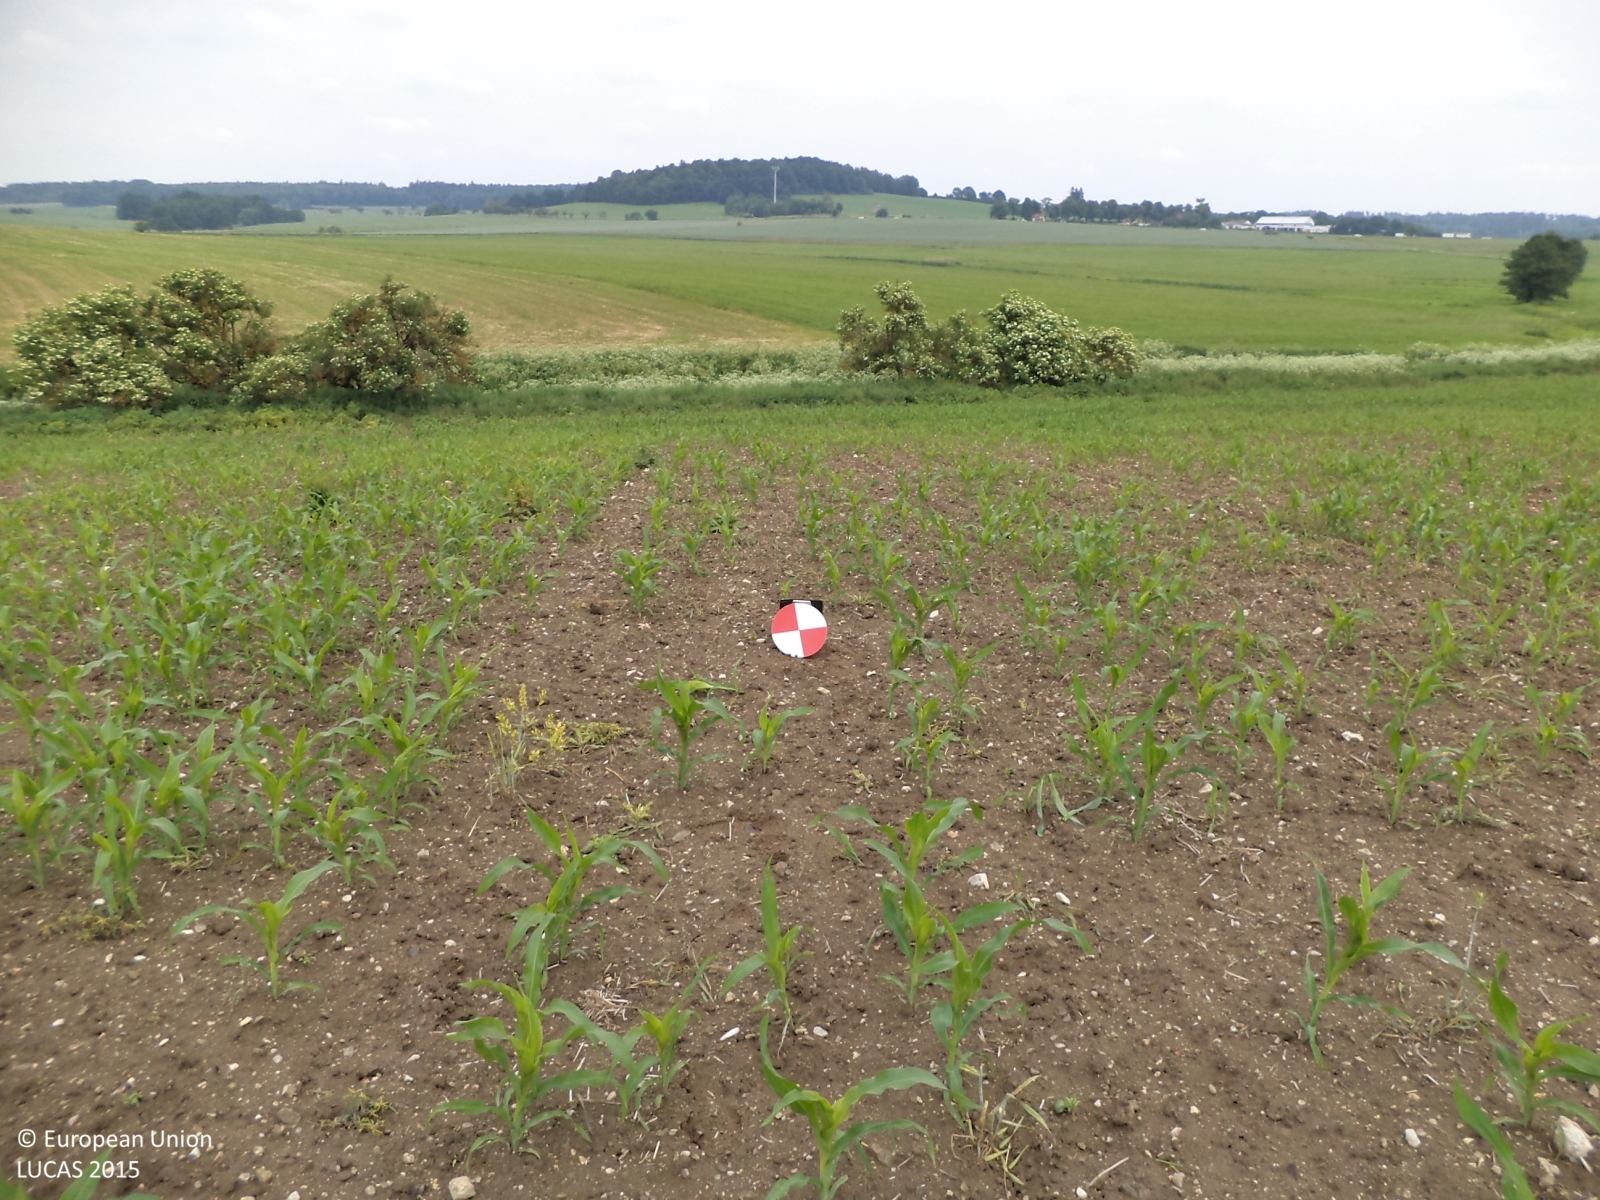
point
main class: Cropland
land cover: Maize
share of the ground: 25 - 50 %
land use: Agriculture (excluding fallow land and kitchen gardens)
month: June
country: CZ
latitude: 49.1088
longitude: 14.3984
